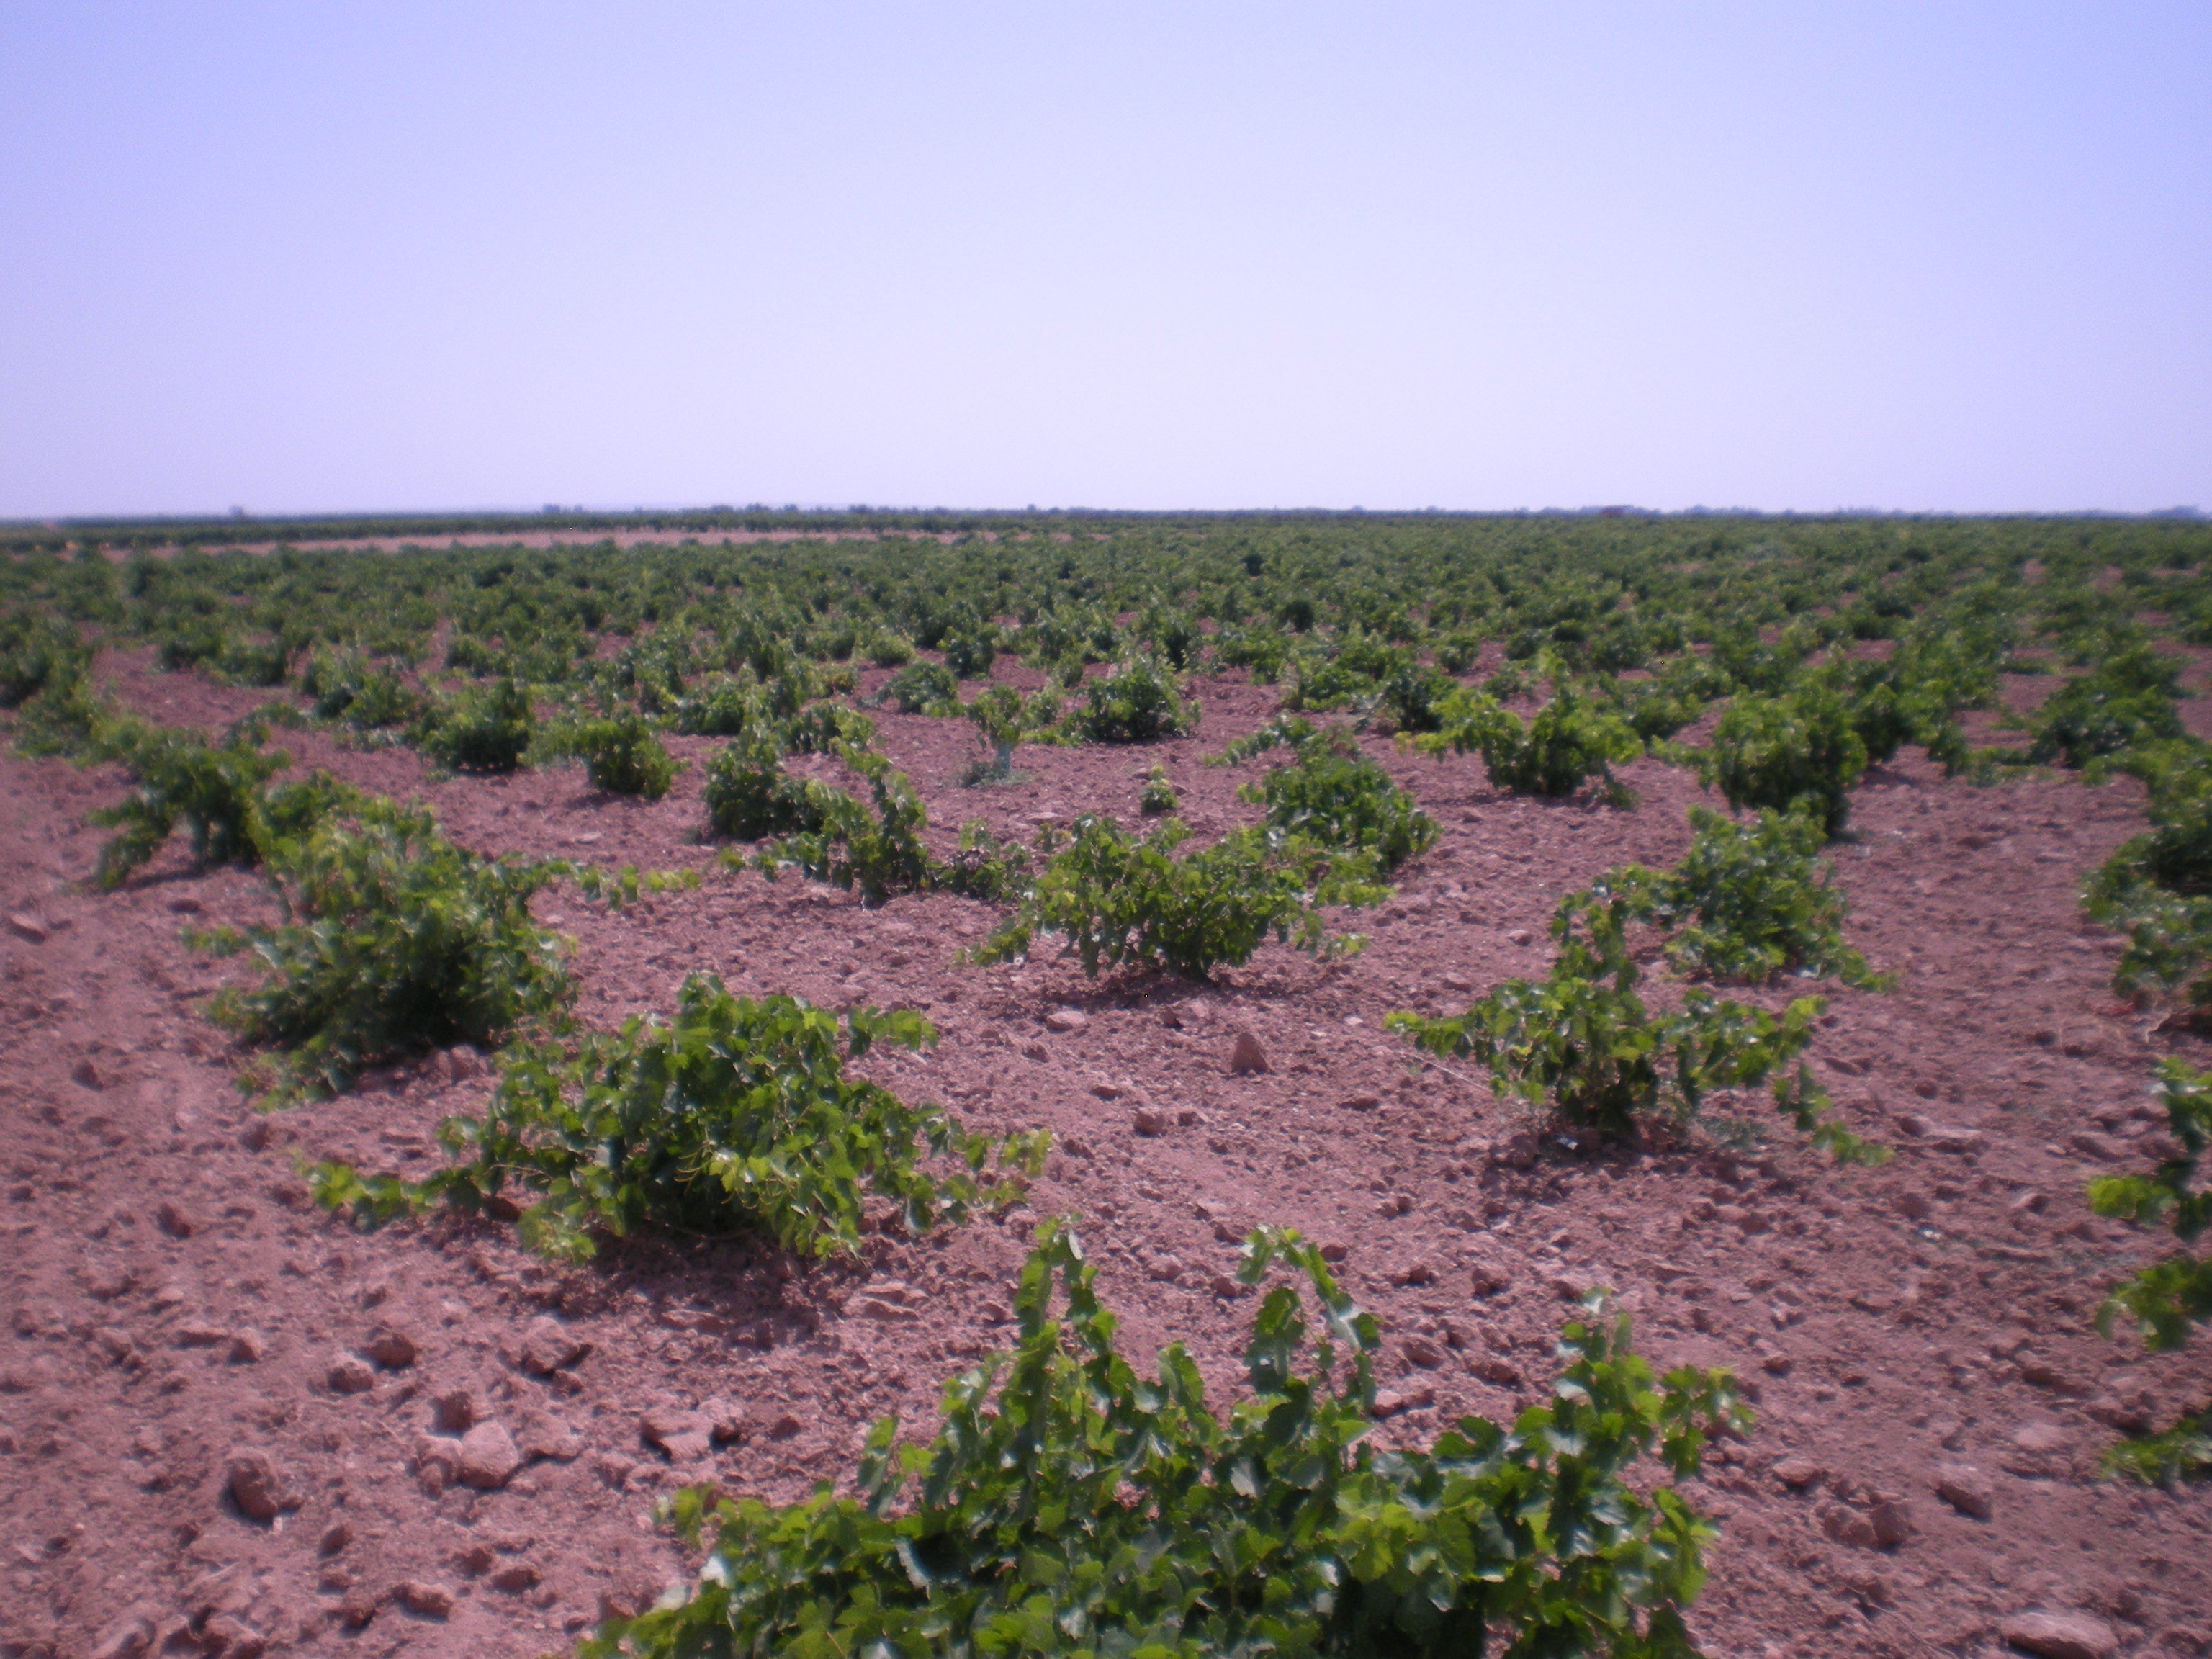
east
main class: Cropland
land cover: Vineyards
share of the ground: 10 - 25 %
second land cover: Other bare soil
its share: > 75 %
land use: Agriculture (excluding fallow land and kitchen gardens)
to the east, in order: Vineyards; Other bare soil; Spontaneously vegetated surfaces; Vineyards
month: June
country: ES
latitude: 39.6310
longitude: -3.1745
